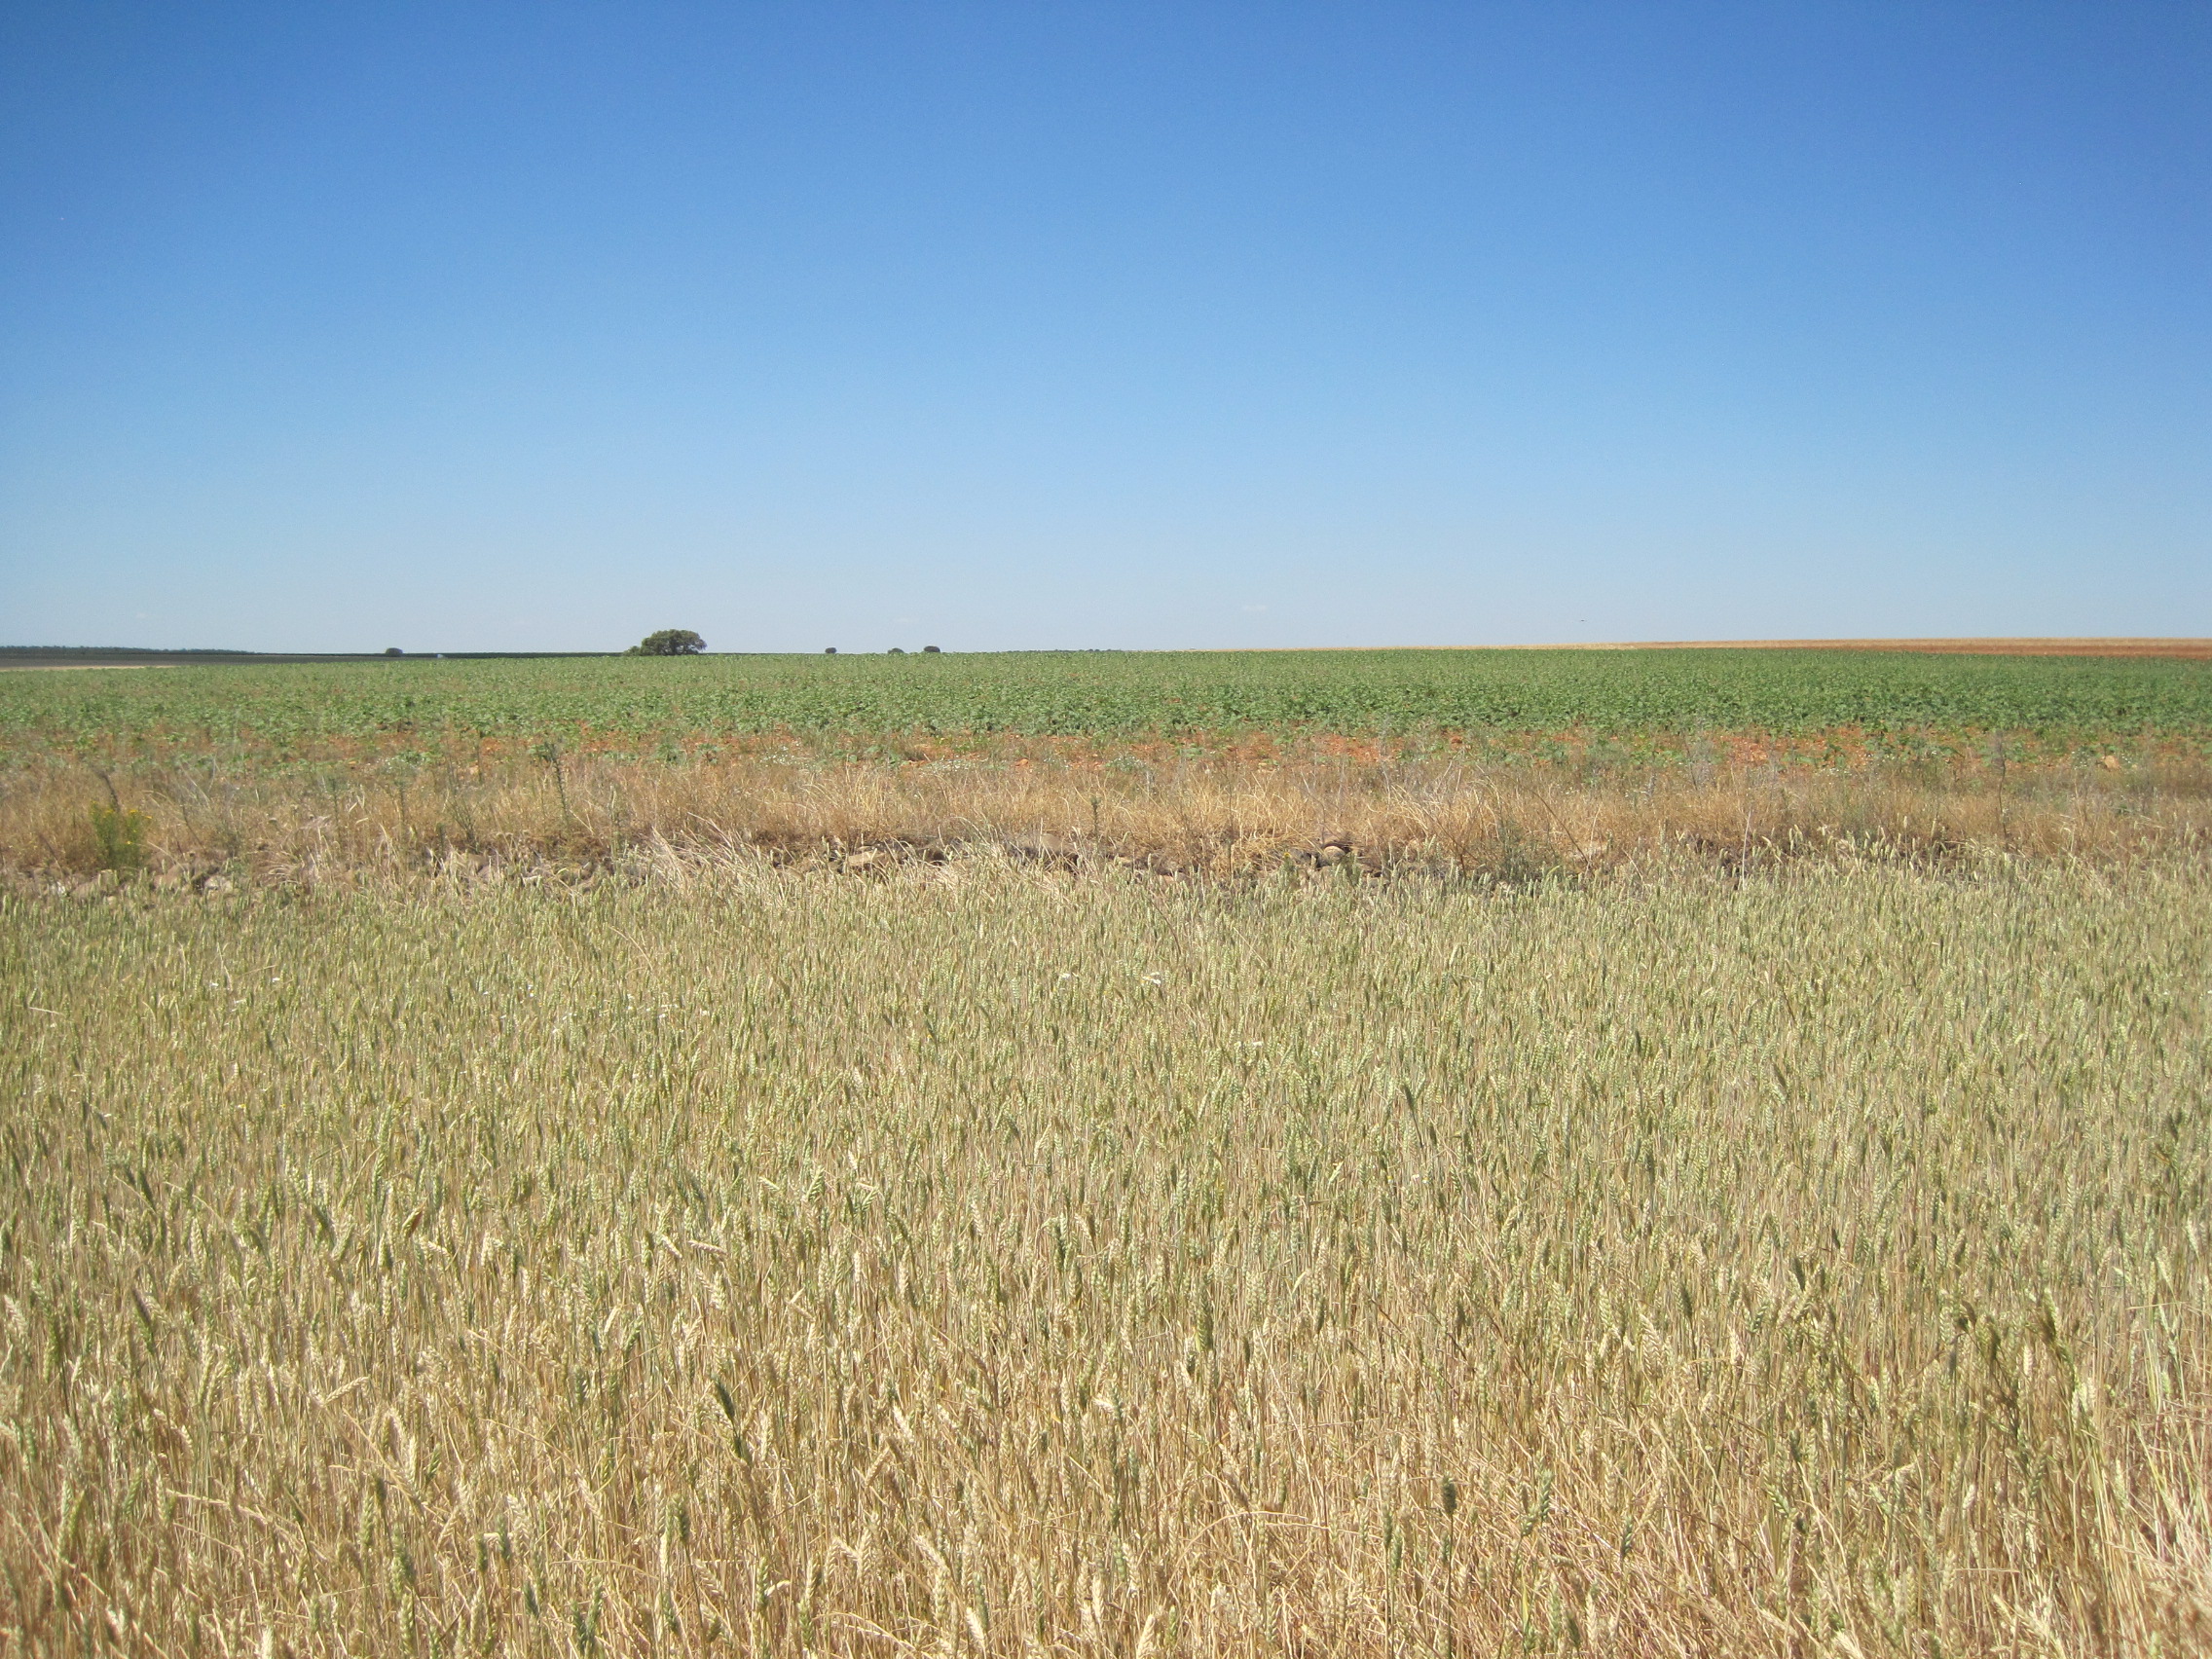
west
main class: Cropland
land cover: Common wheat
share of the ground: > 75 %
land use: Agriculture (excluding fallow land and kitchen gardens)
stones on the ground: 10 - 25 %
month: June
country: ES
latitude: 41.8015
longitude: -5.3802
